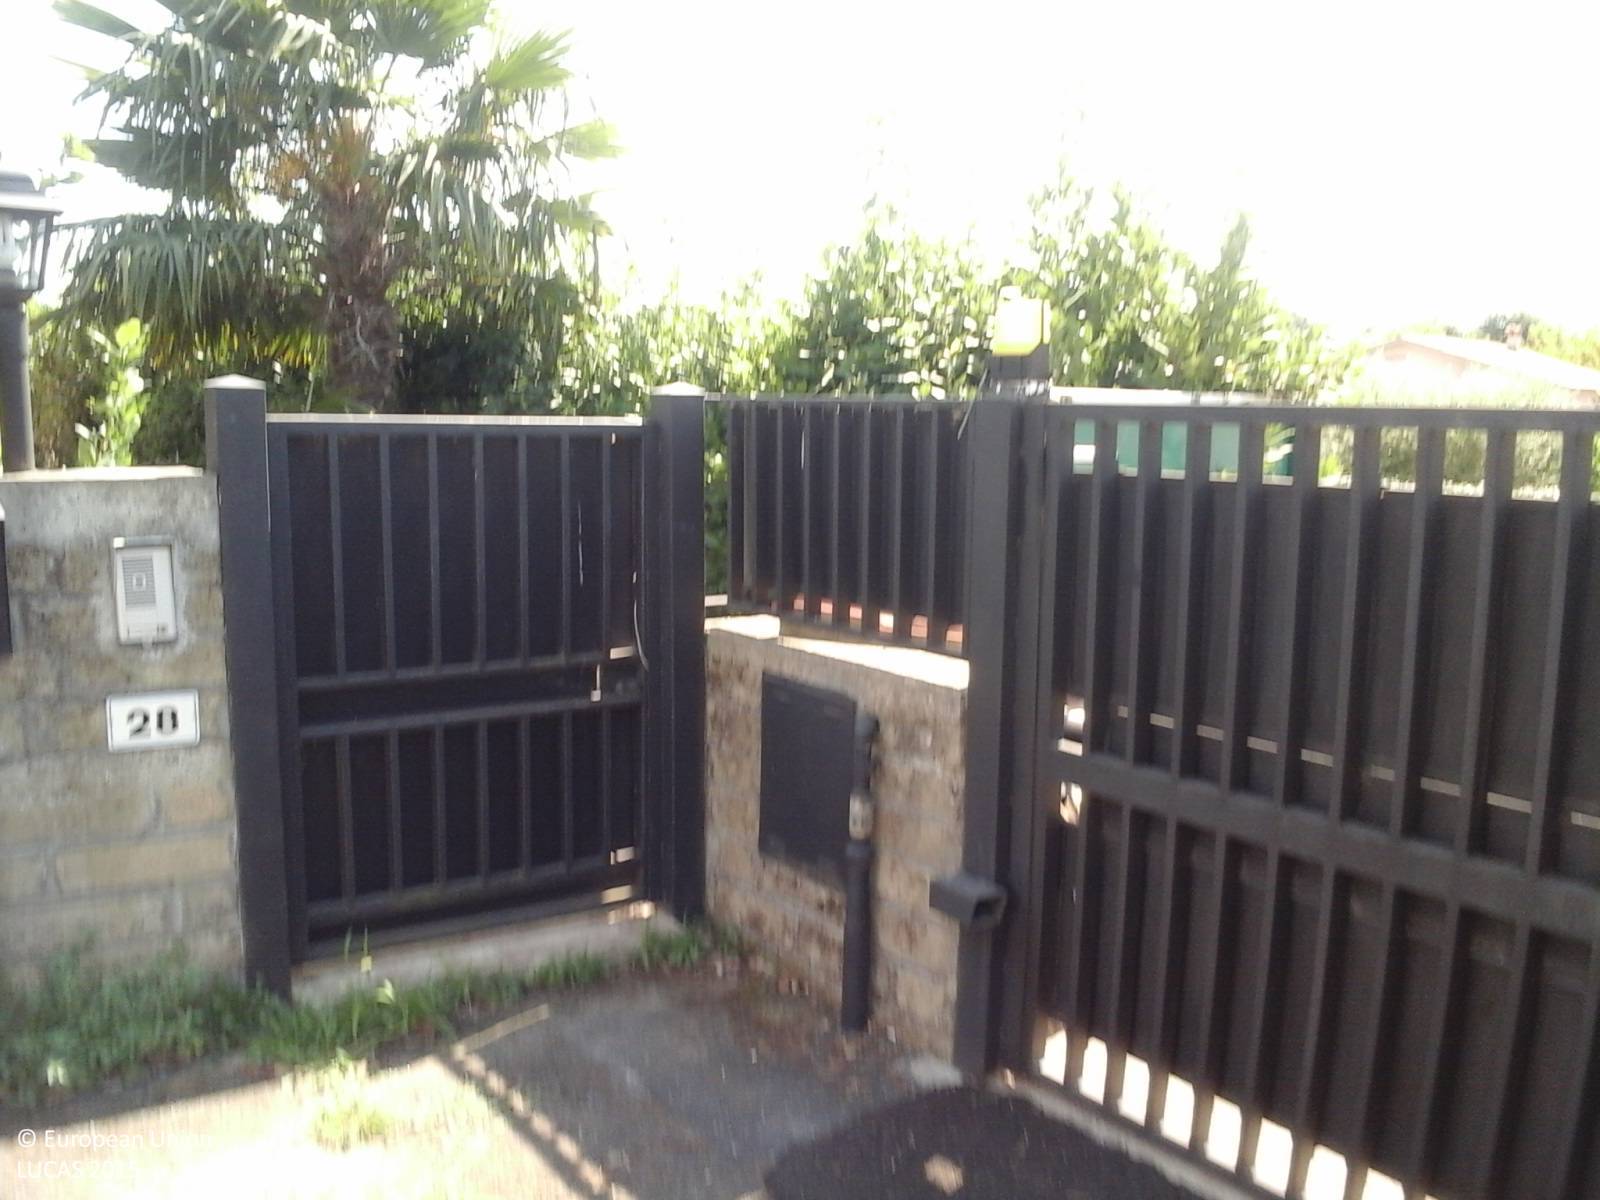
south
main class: Grassland
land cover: Grassland with sparse tree/shrub cover
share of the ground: > 75 %
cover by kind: herbaceous plants 90 %, broadleaved forest trees 5 %, shrubs 5 %
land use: Residential
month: August
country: IT
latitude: 42.0863
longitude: 12.2766
